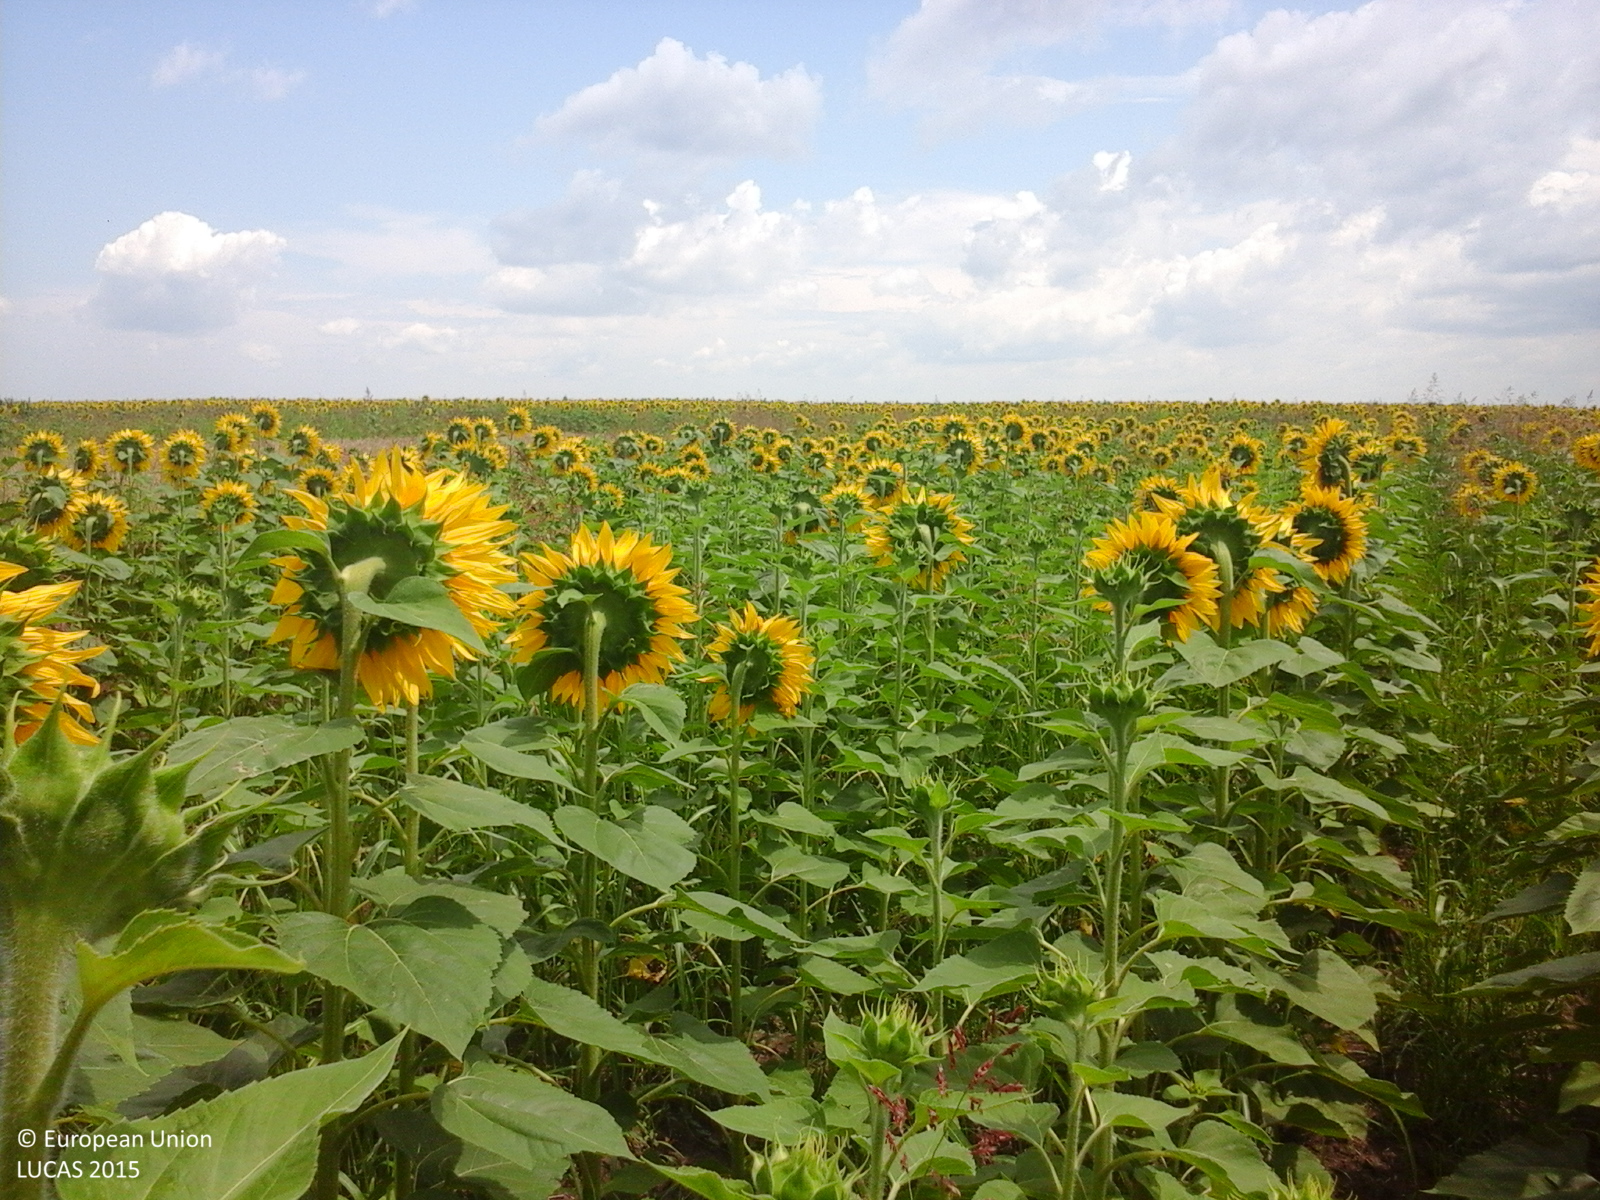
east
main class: Cropland
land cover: Sunflower
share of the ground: > 75 %
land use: Agriculture (excluding fallow land and kitchen gardens)
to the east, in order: Sunflower; Grass margins; Sunflower; Rape and turnip rape
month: July
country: RO
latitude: 44.0070
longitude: 24.4716
